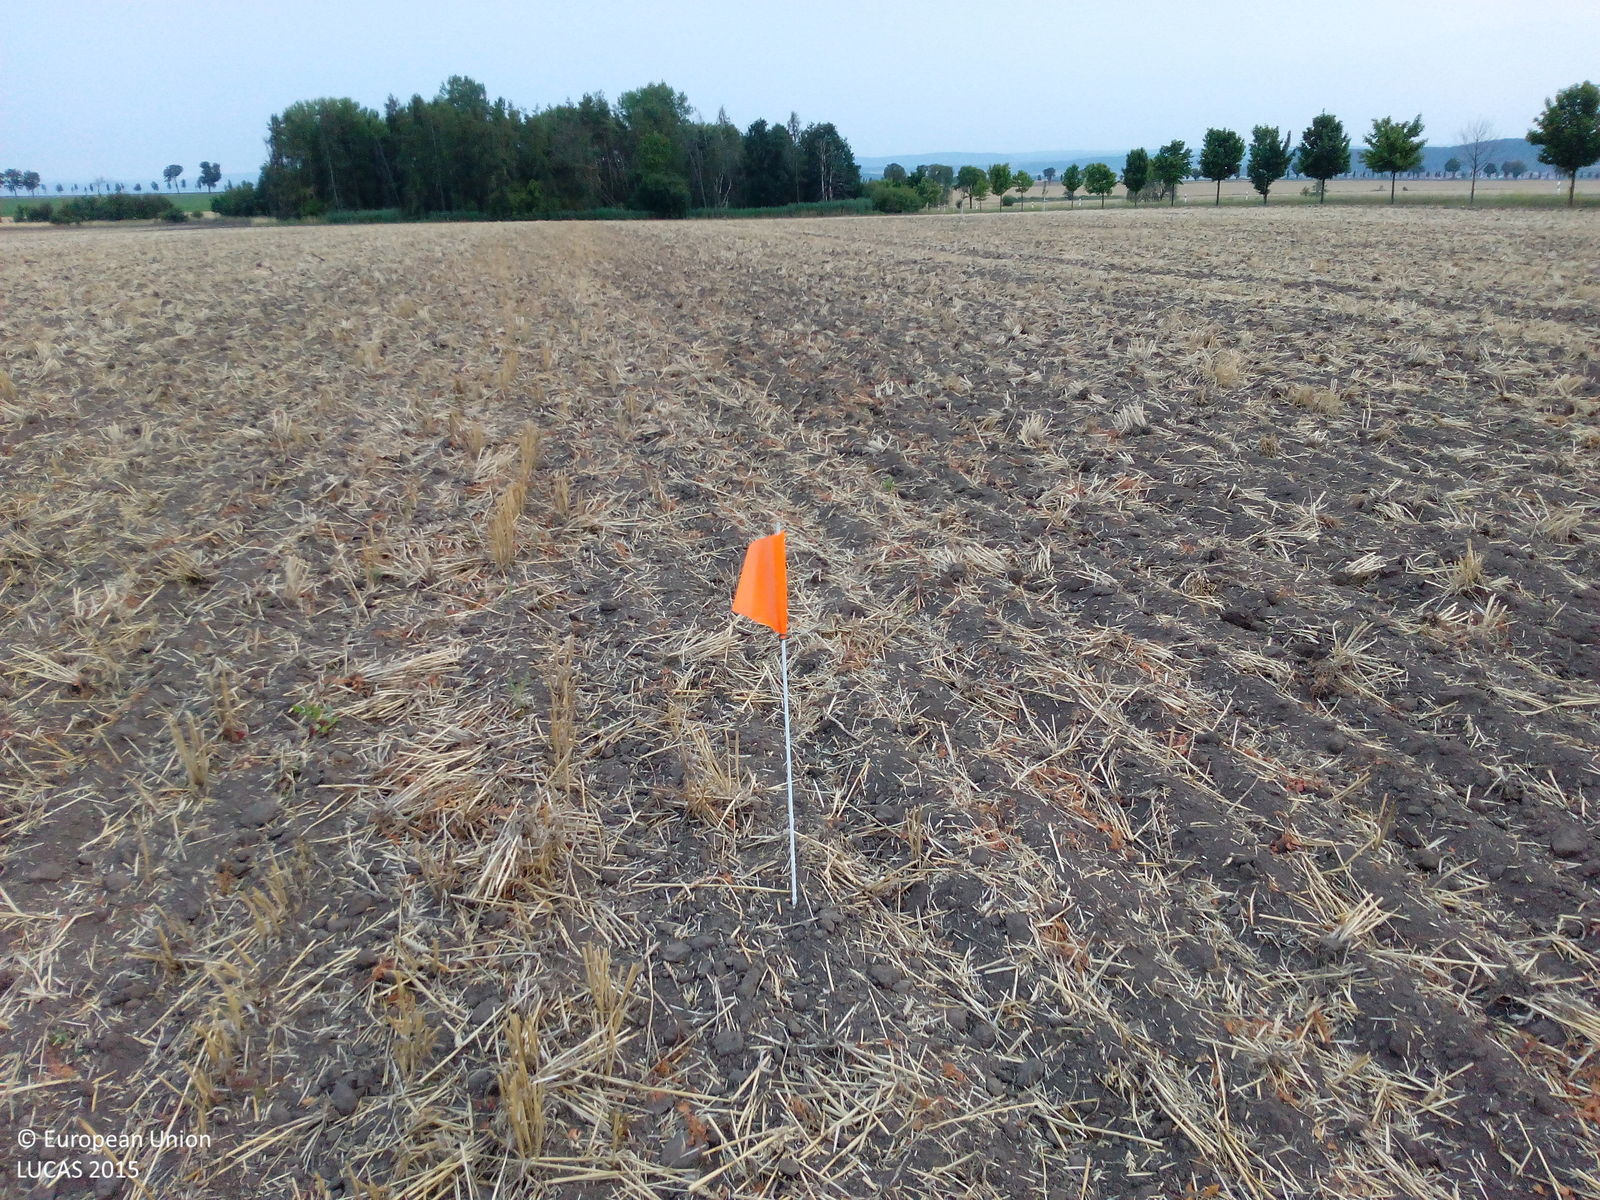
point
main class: Cropland
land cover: Common wheat
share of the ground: < 10 %
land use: Agriculture (excluding fallow land and kitchen gardens)
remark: Harvested field
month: August
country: DE
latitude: 50.9543
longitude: 10.8397
